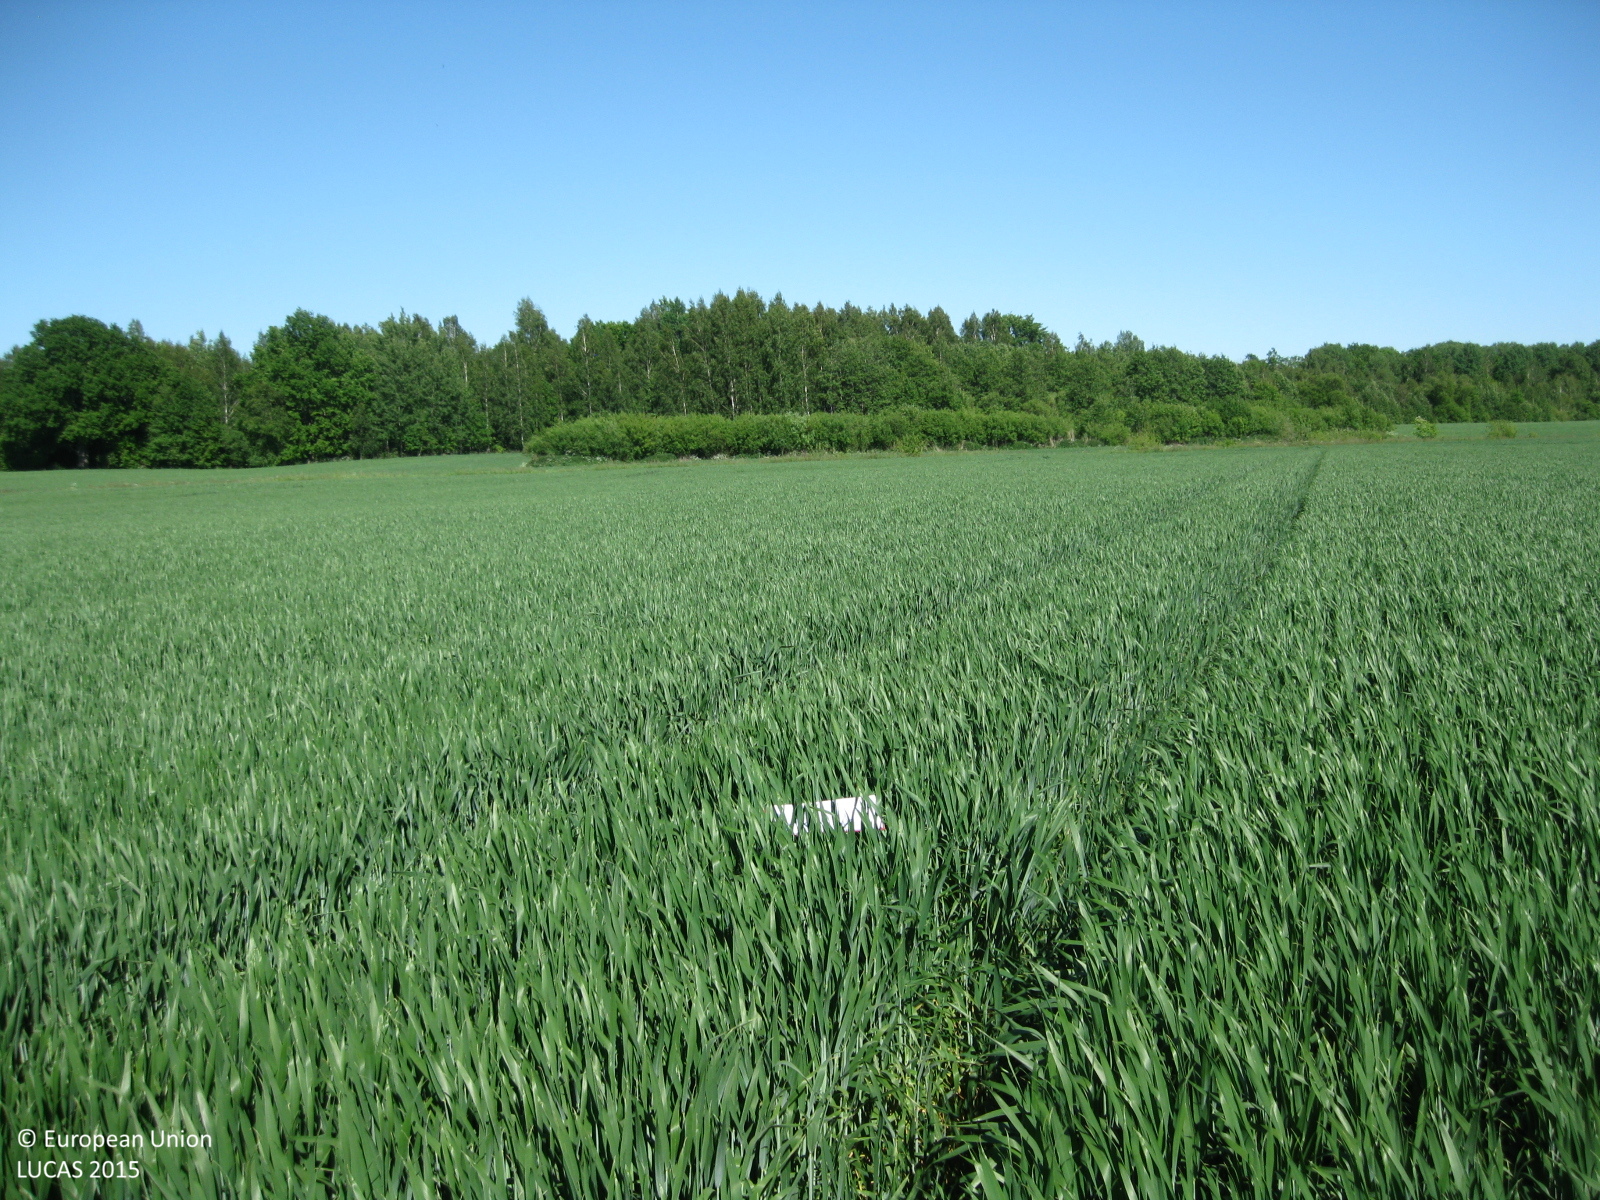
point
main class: Cropland
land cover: Common wheat
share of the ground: > 75 %
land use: Agriculture (excluding fallow land and kitchen gardens)
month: June
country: LT
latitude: 55.7025
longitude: 24.0447
